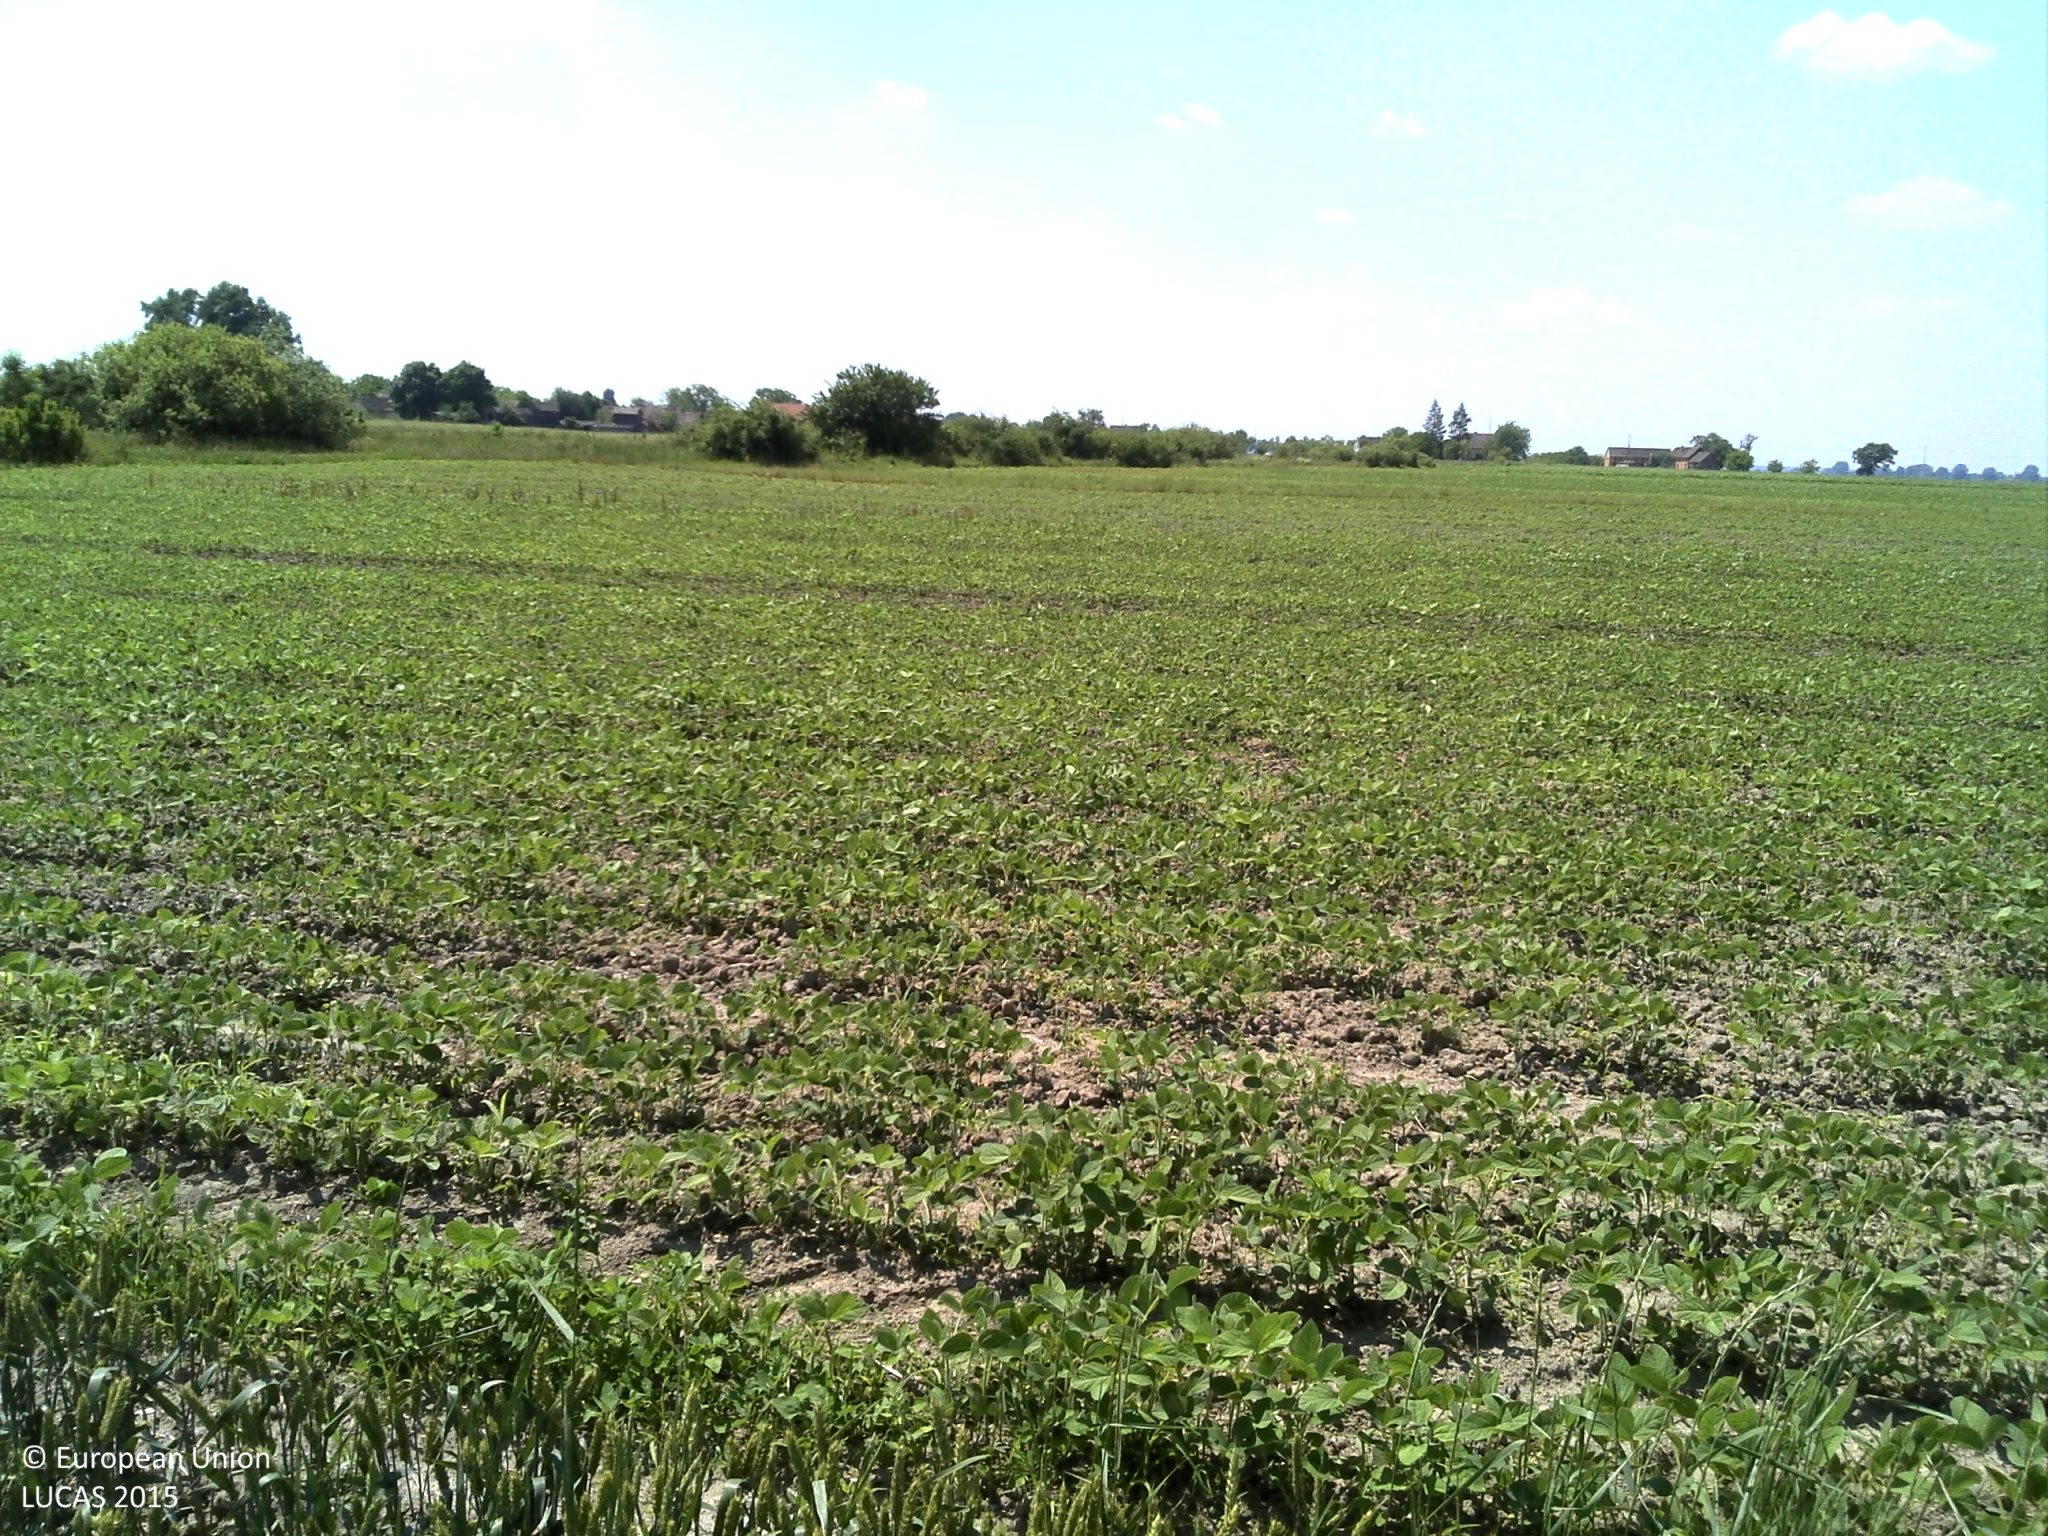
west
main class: Cropland
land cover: Common wheat
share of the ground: > 75 %
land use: Agriculture (excluding fallow land and kitchen gardens)
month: June
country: HR
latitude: 44.9567
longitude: 18.9944
